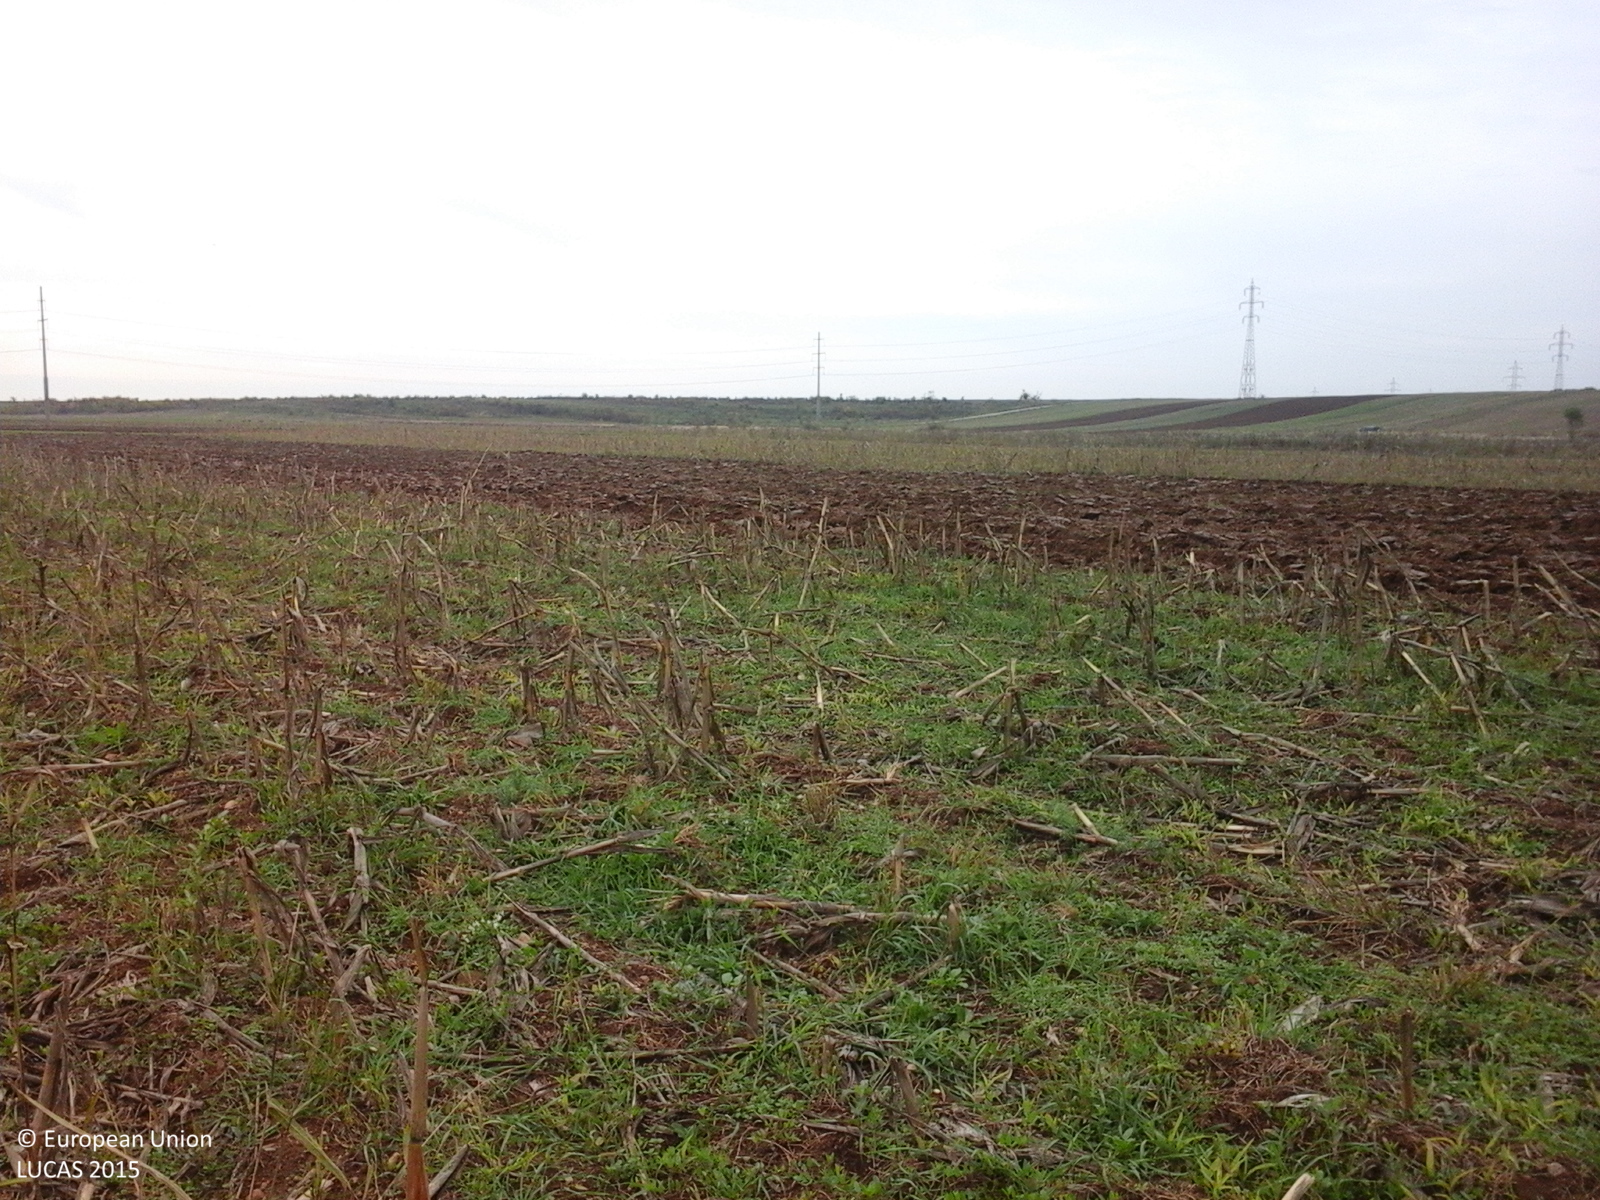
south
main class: Cropland
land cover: Maize
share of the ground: 50 - 75 %
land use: Agriculture (excluding fallow land and kitchen gardens)
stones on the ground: < 10 %
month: October
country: RO
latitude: 44.9500
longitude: 25.4181
